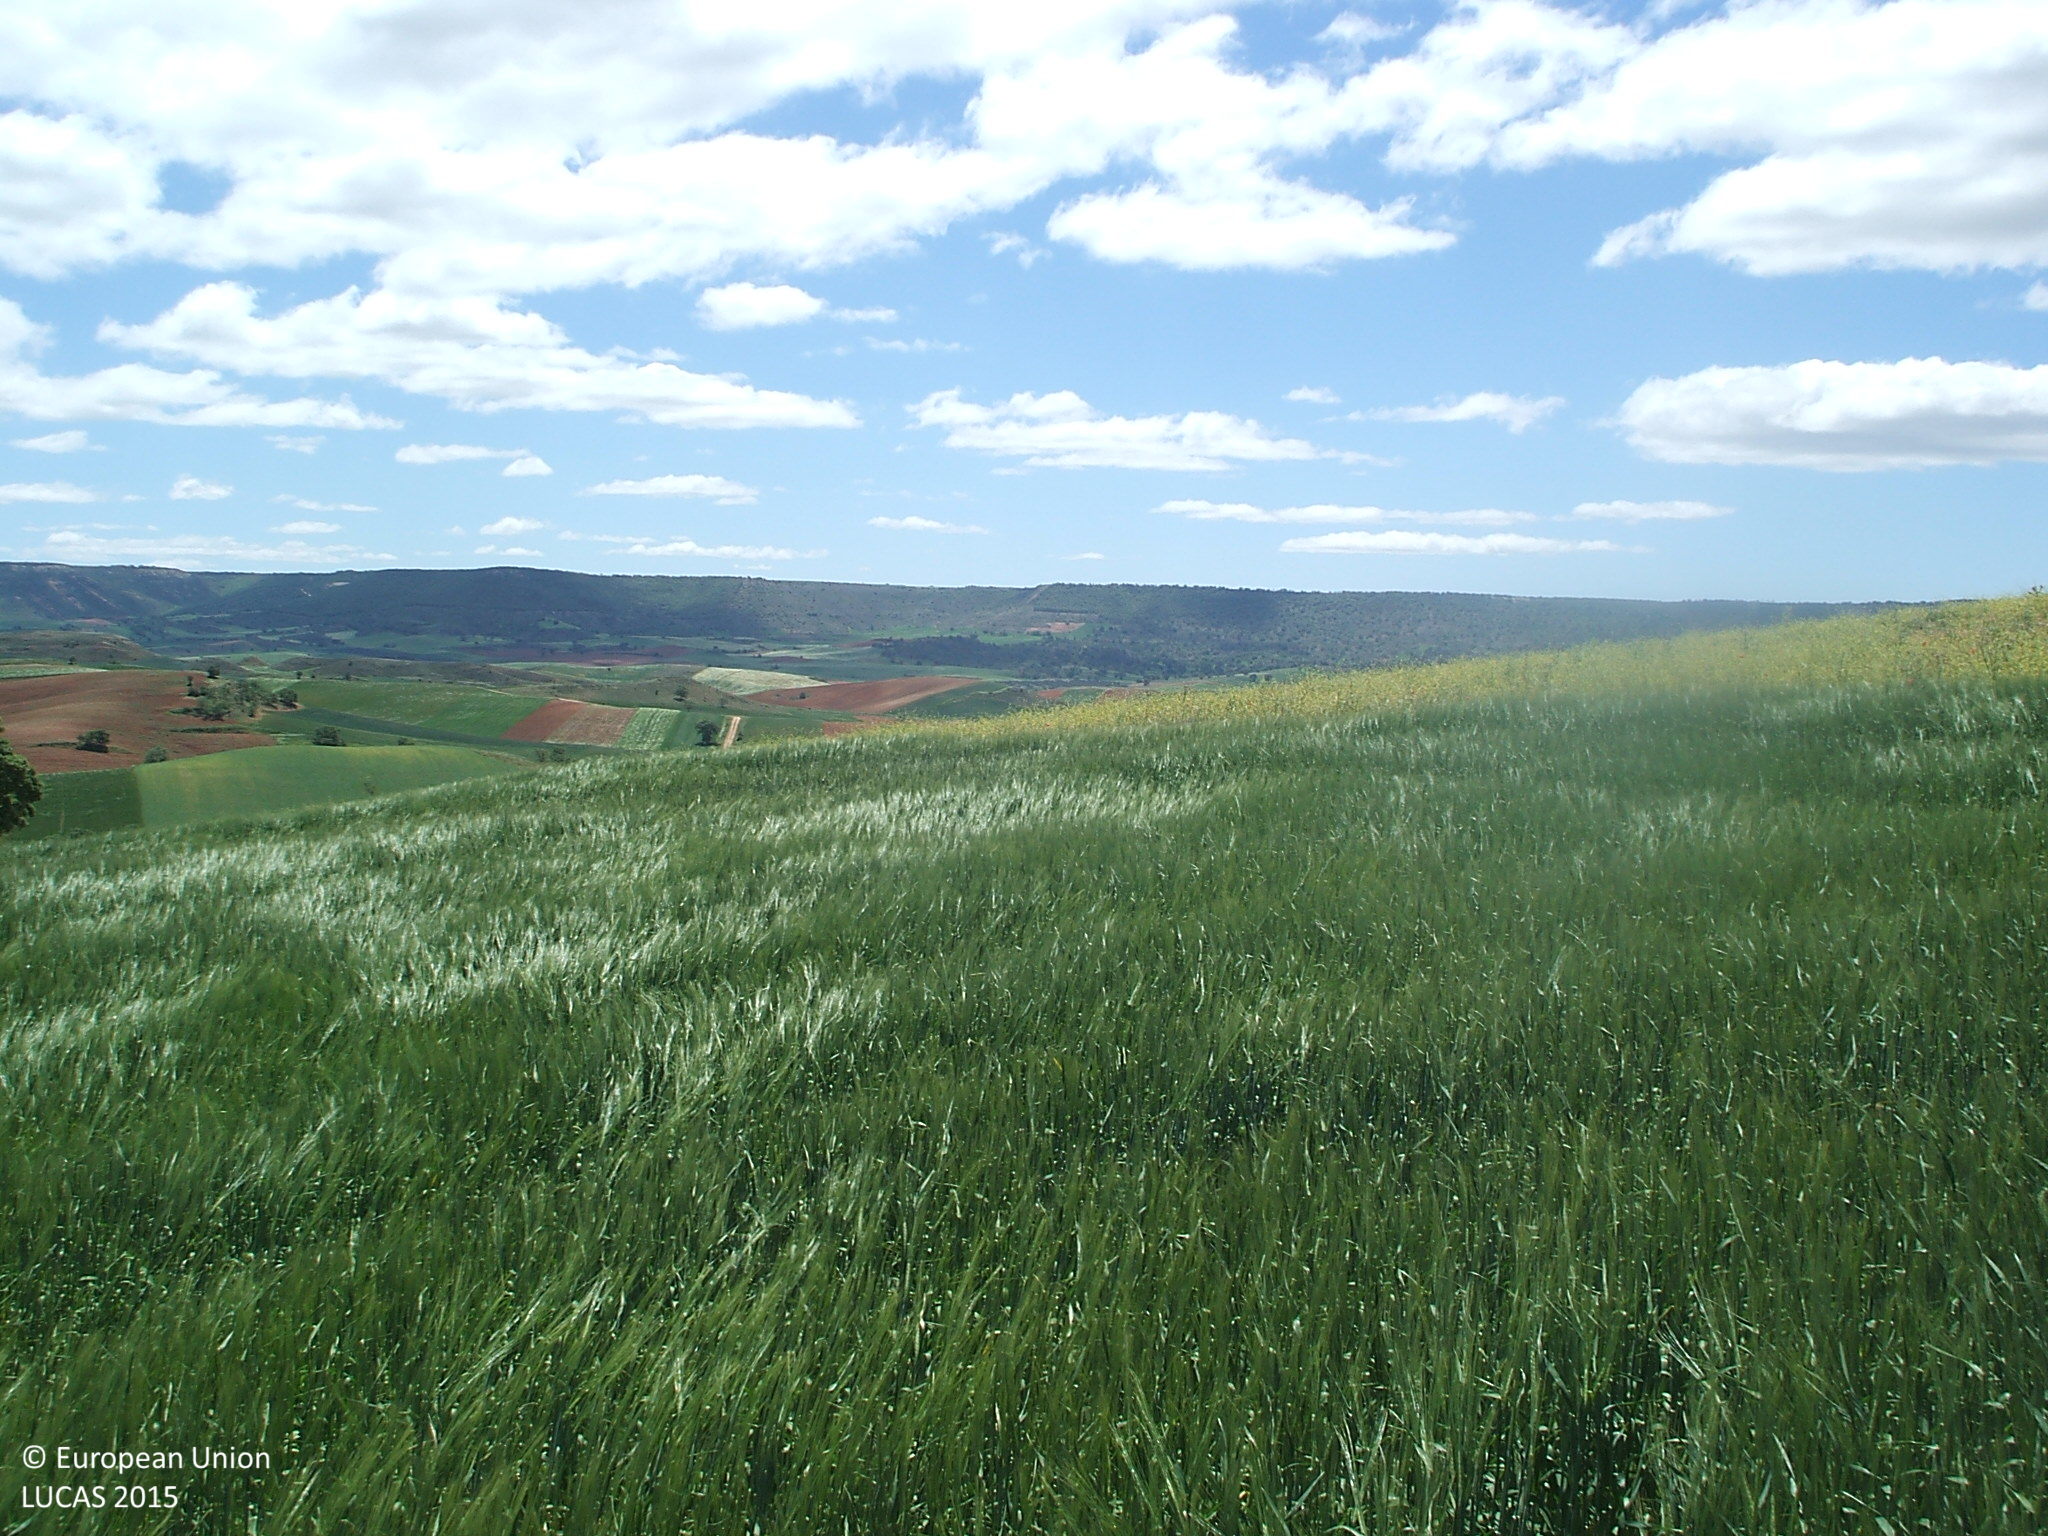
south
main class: Cropland
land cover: Barley
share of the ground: > 75 %
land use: Agriculture (excluding fallow land and kitchen gardens)
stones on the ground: 25 - 50 %
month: May
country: ES
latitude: 40.9691
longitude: -2.8794
